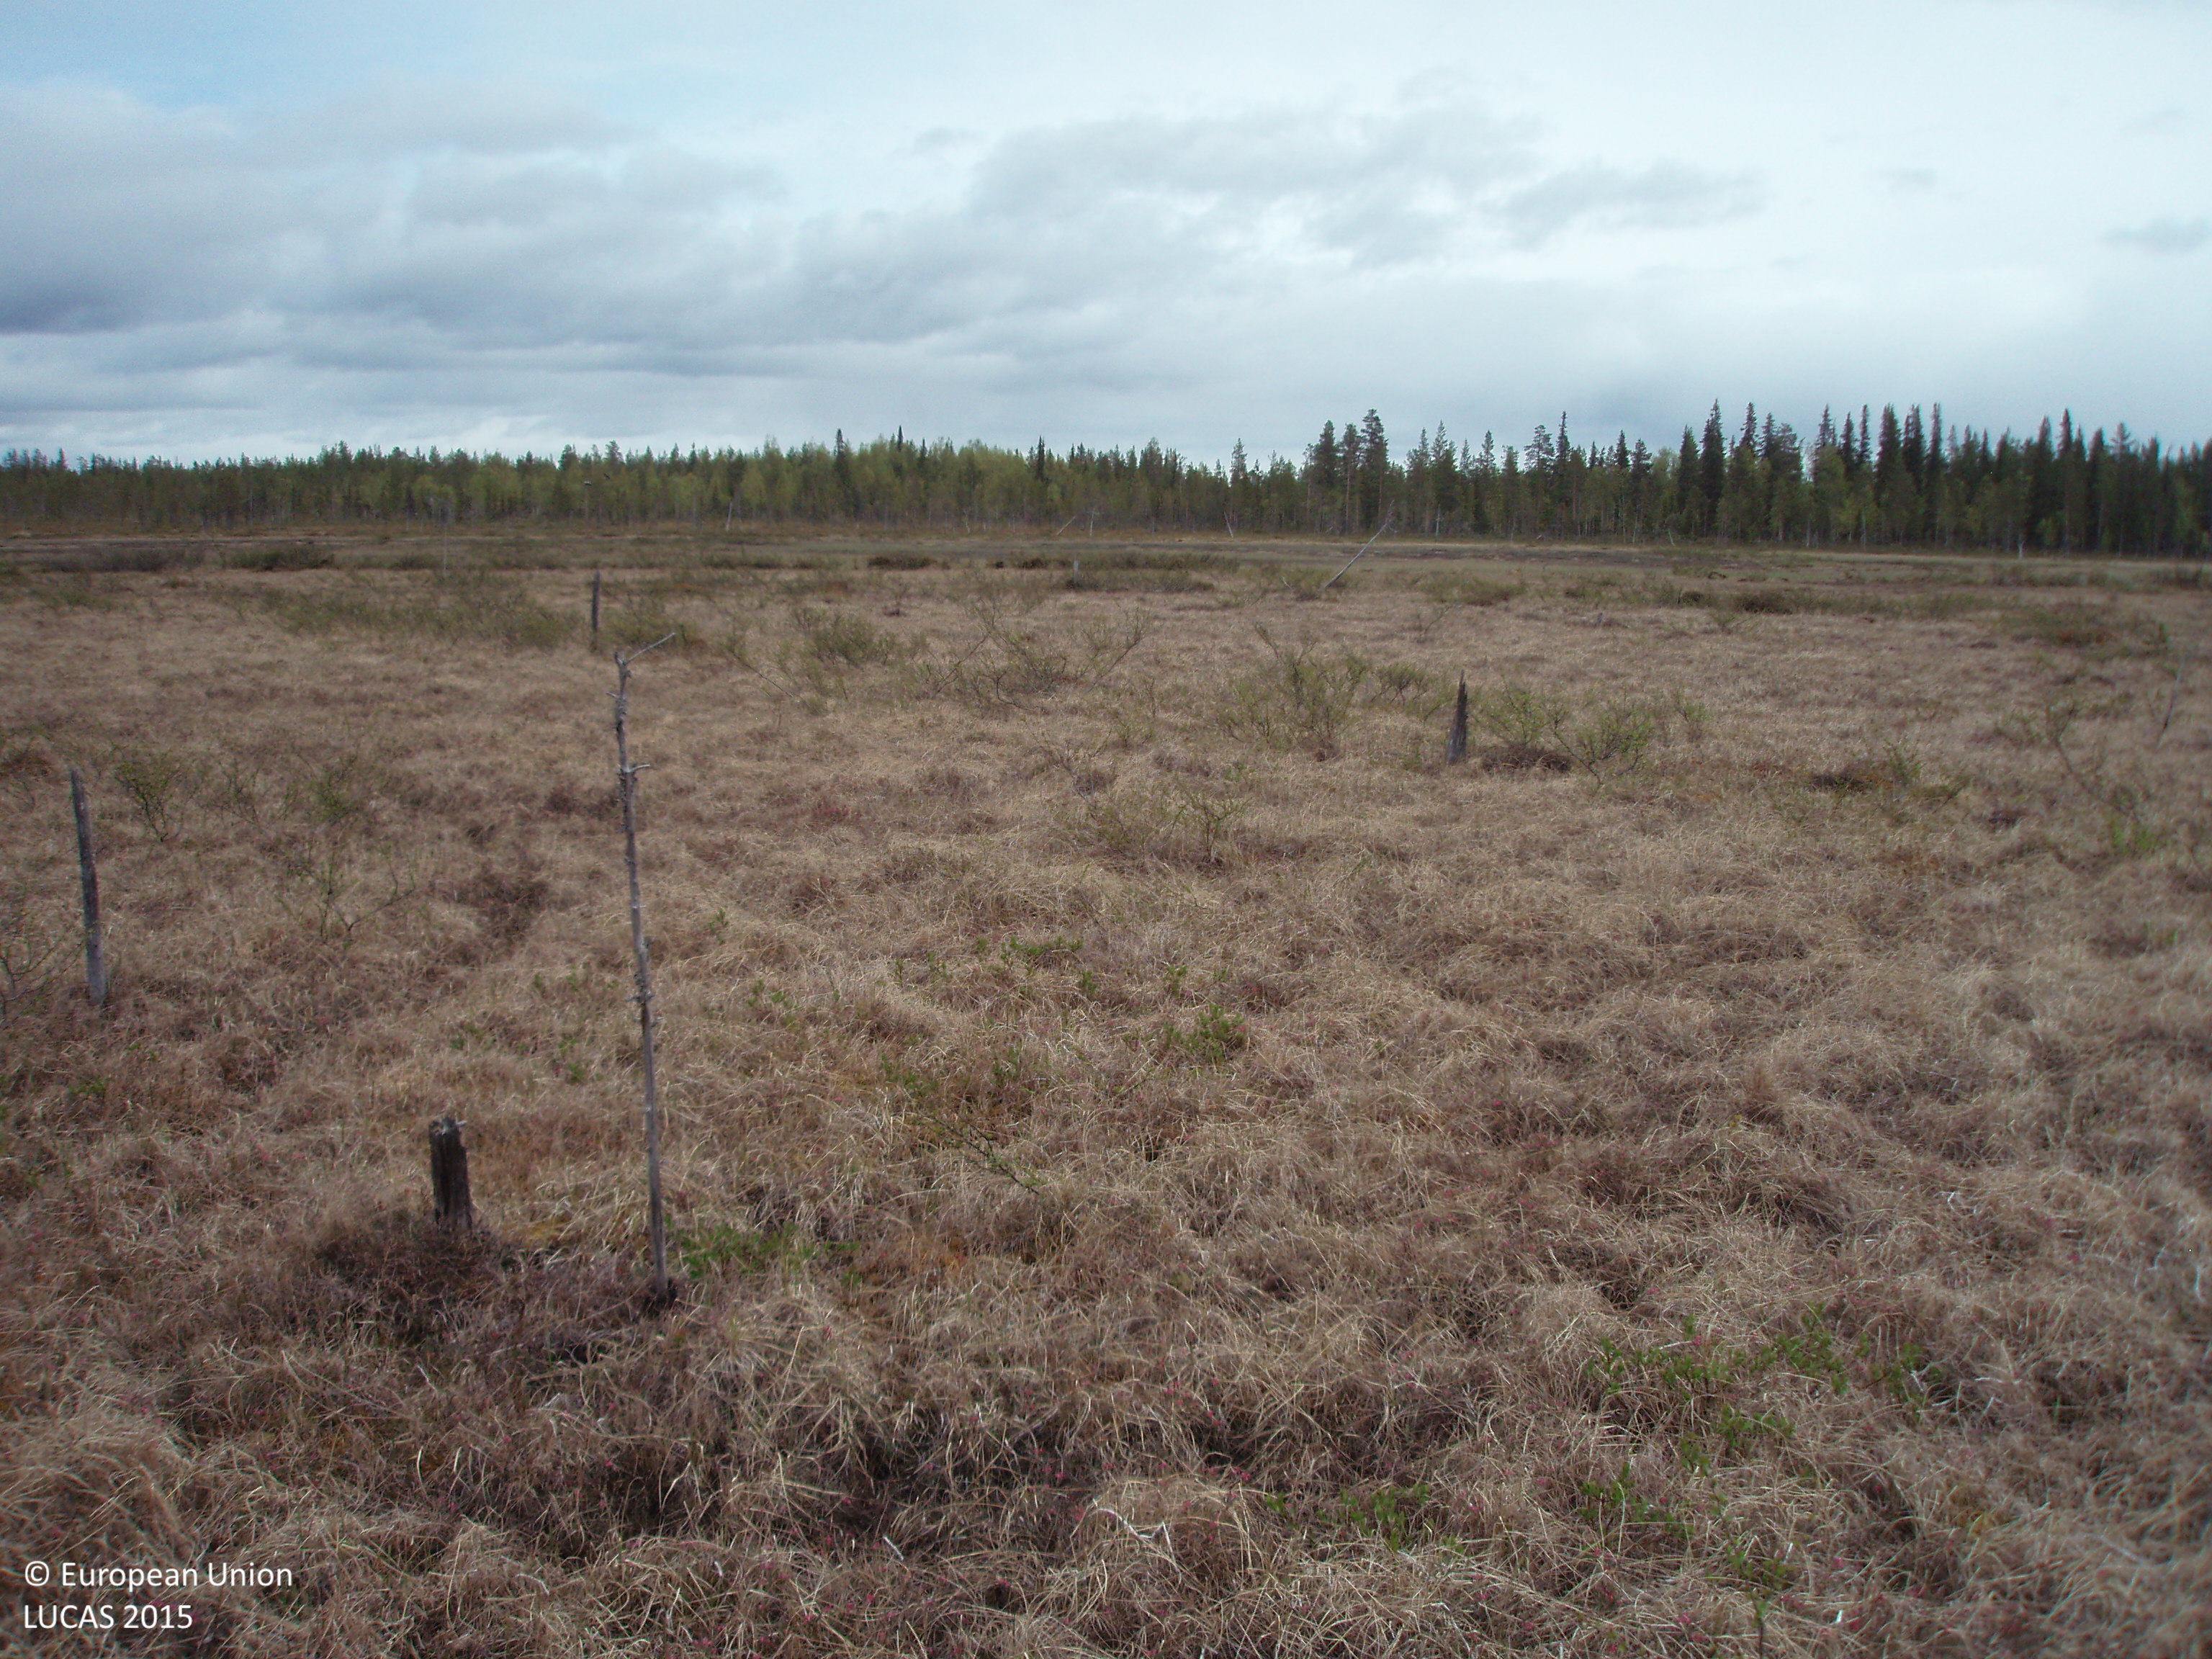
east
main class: Shrubland
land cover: Shrubland without tree cover
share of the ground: > 75 %
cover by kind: shrubs 60 %, herbaceous plants 40 %
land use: Semi-natural and natural areas not in use
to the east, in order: Shrubland without tree cover; Peatbogs; Pine dominated coniferous woodland
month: June
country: FI
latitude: 67.9625
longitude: 26.7637
